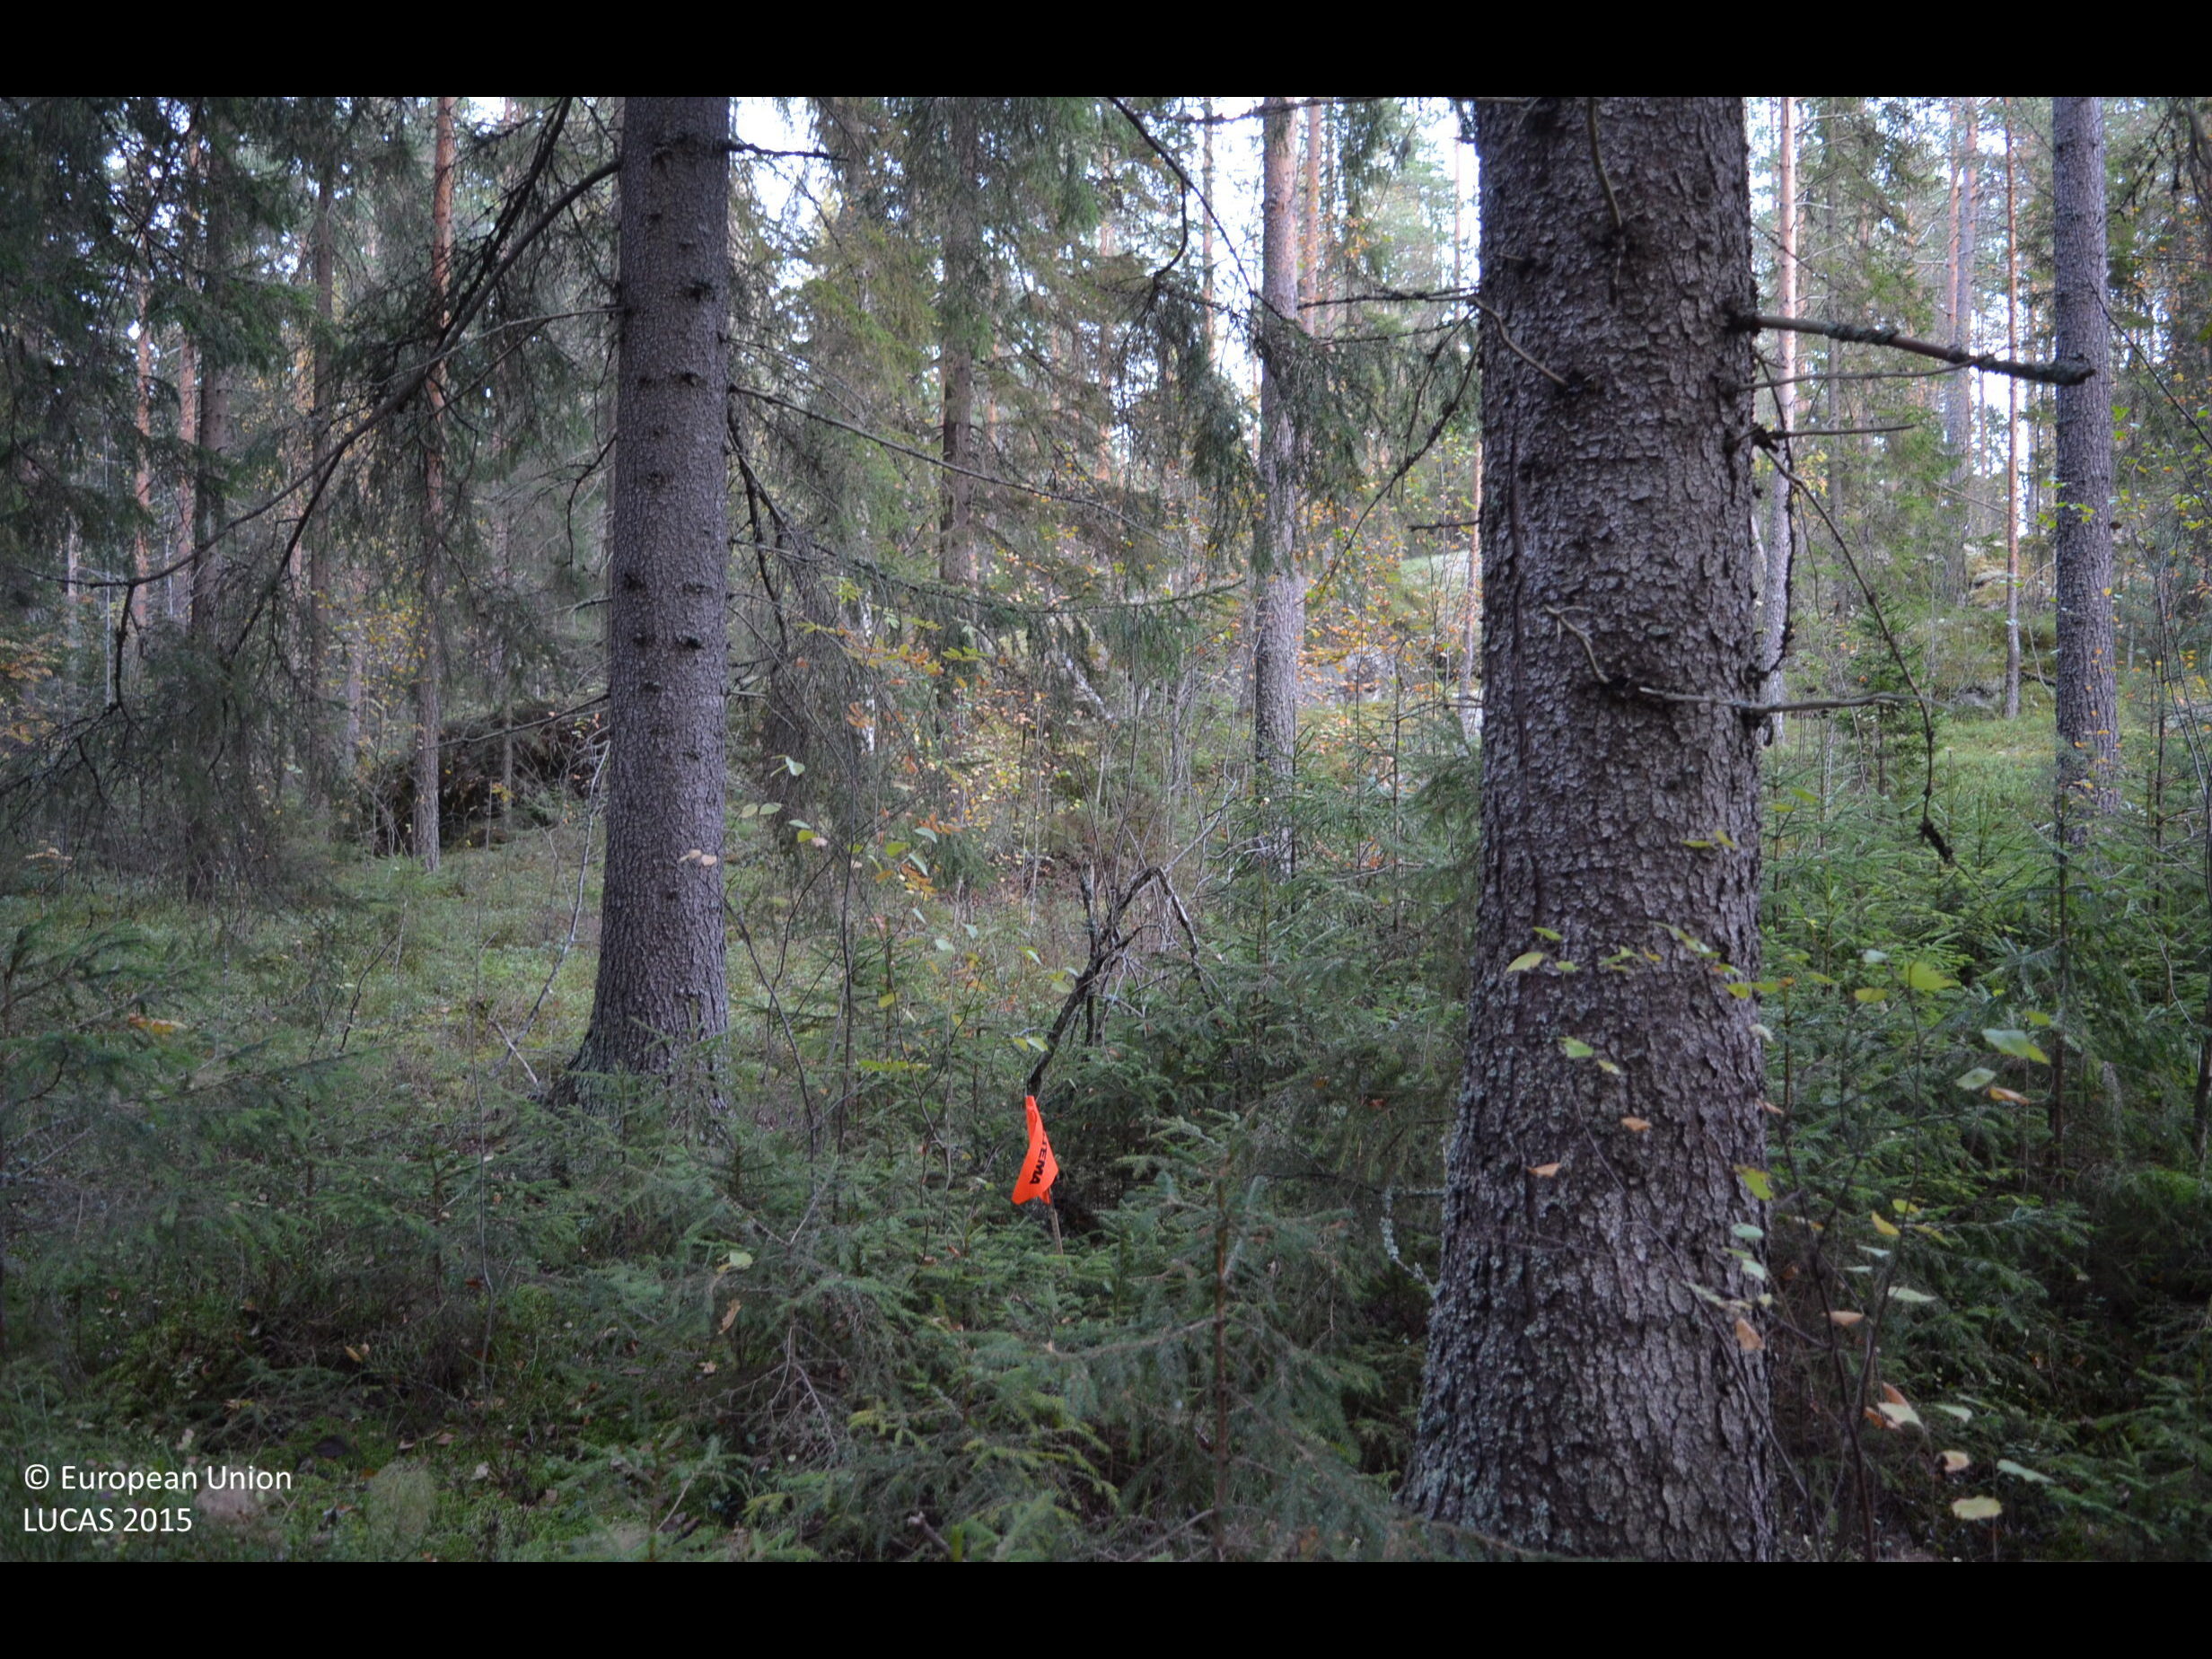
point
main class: Woodland
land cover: Spruce dominated coniferous woodland
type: boreal forest
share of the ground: > 75 %
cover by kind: coniferous forest trees 60 %, shrubs 20 %, broadleaved forest trees 15 %, lichens and mosses 5 %
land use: Forestry
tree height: > 5 m
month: October
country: FI
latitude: 61.7442
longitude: 23.8882
